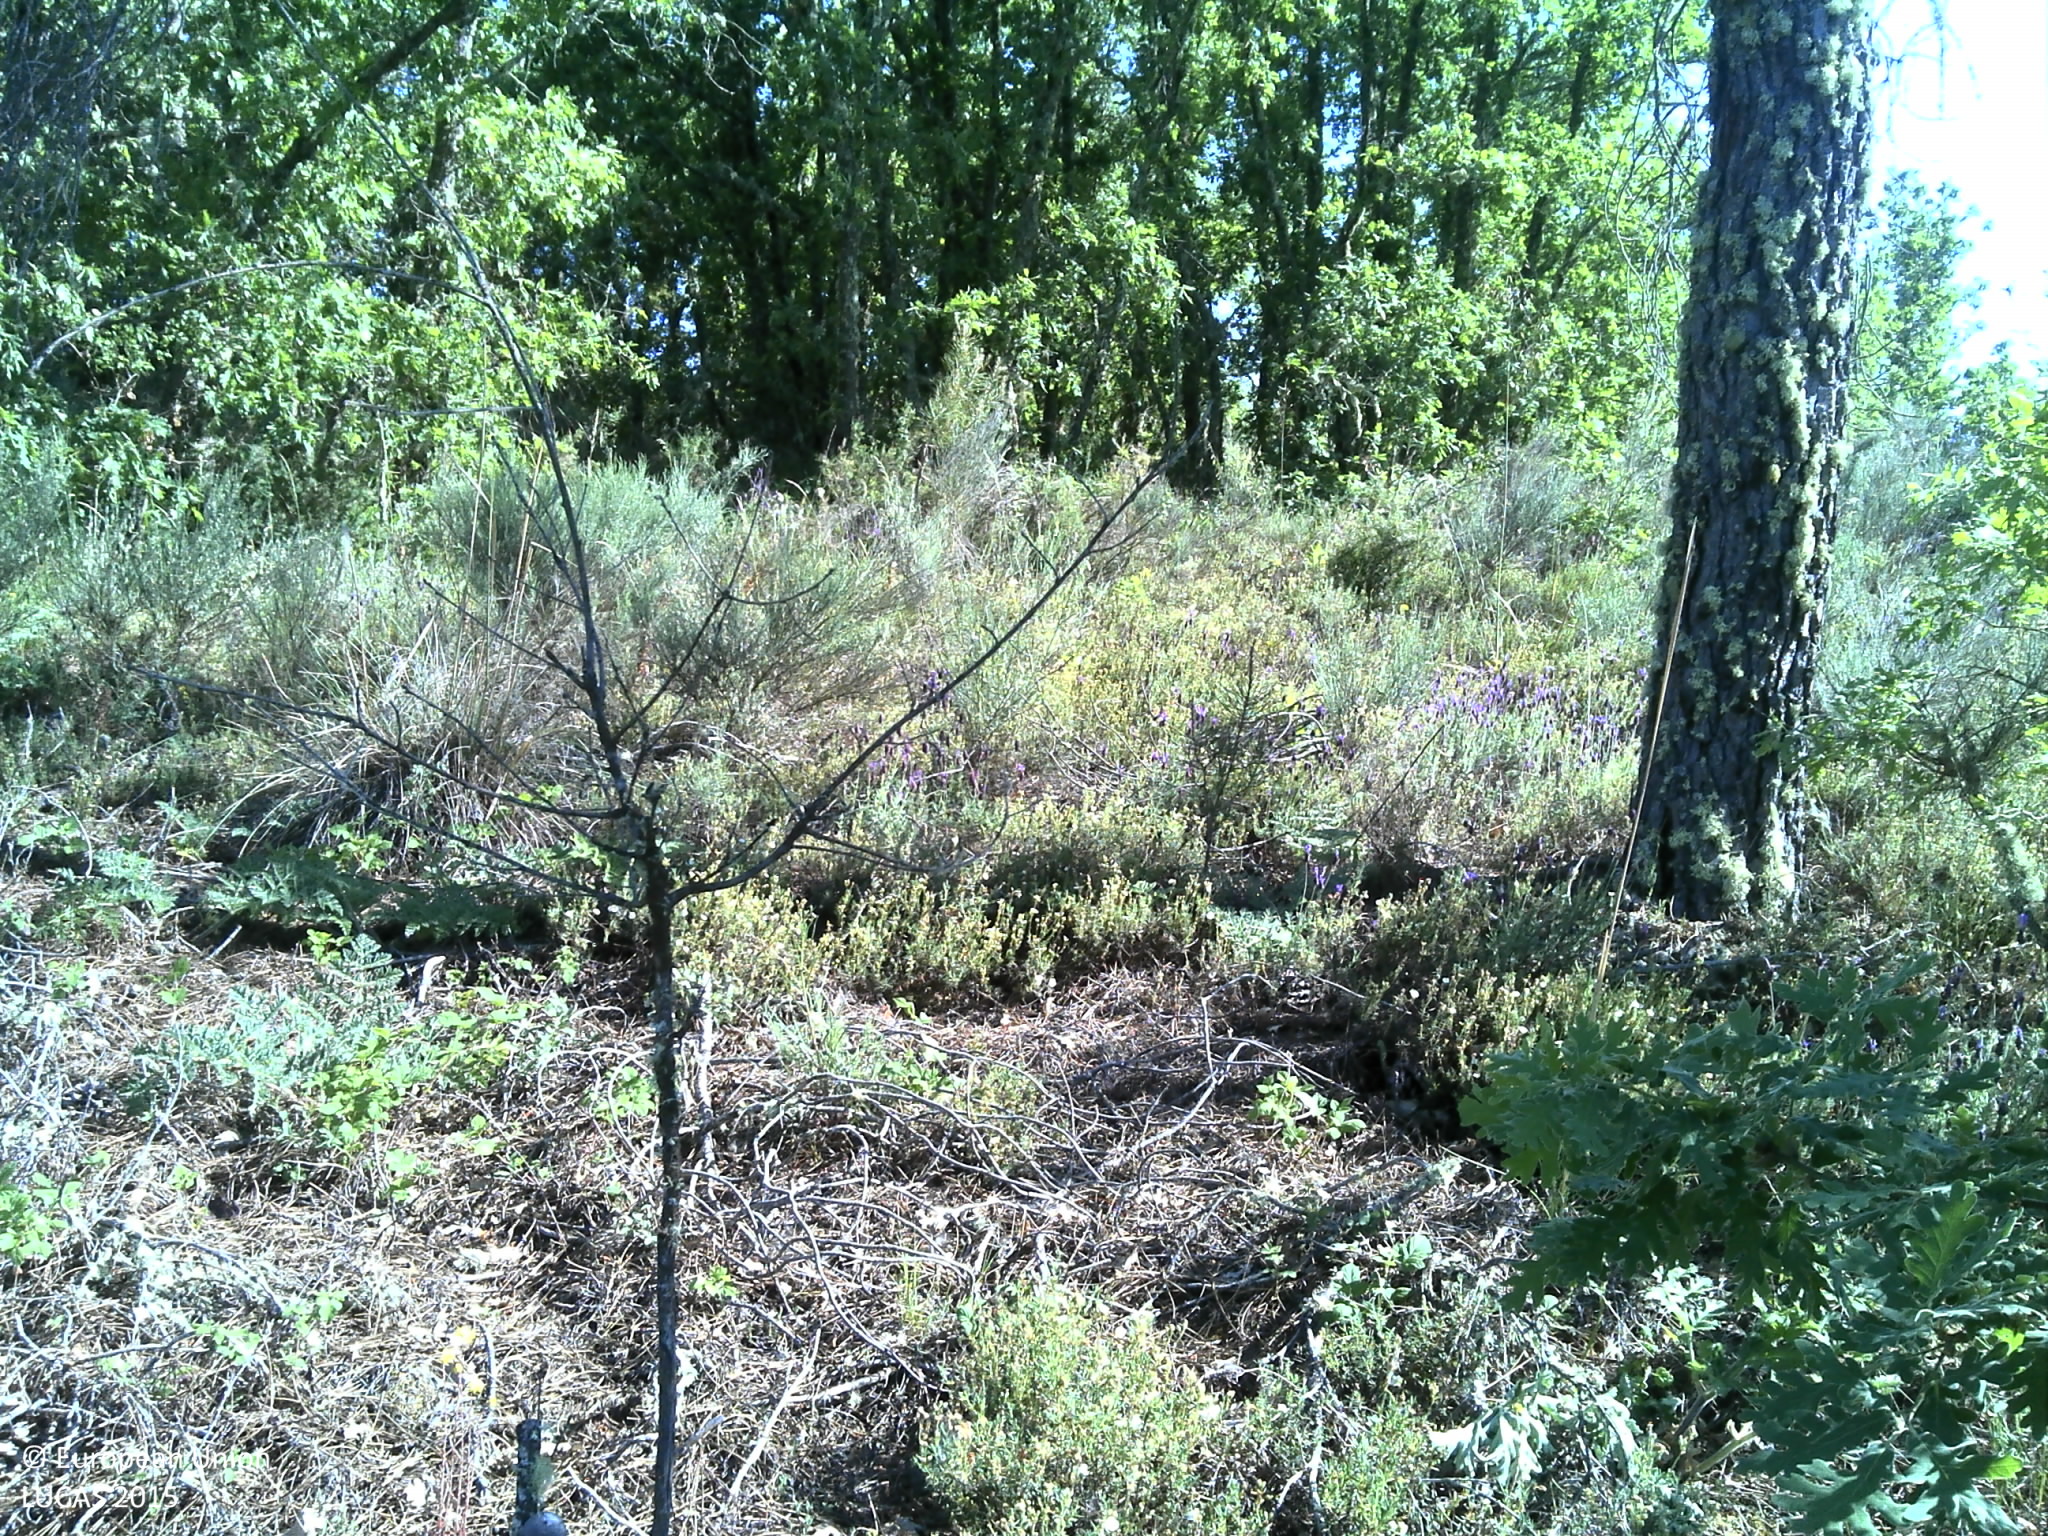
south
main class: Woodland
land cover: Other mixed woodland
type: acidophilous oak and oak-birch forest
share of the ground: 10 - 25 %
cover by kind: shrubs 35 %, herbaceous plants 20 %, unconsolidated bare surface 20 %, broadleaved forest trees 15 %, coniferous forest trees 10 %
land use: Forestry
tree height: > 5 m
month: May
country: PT
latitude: 41.6290
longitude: -6.3415
